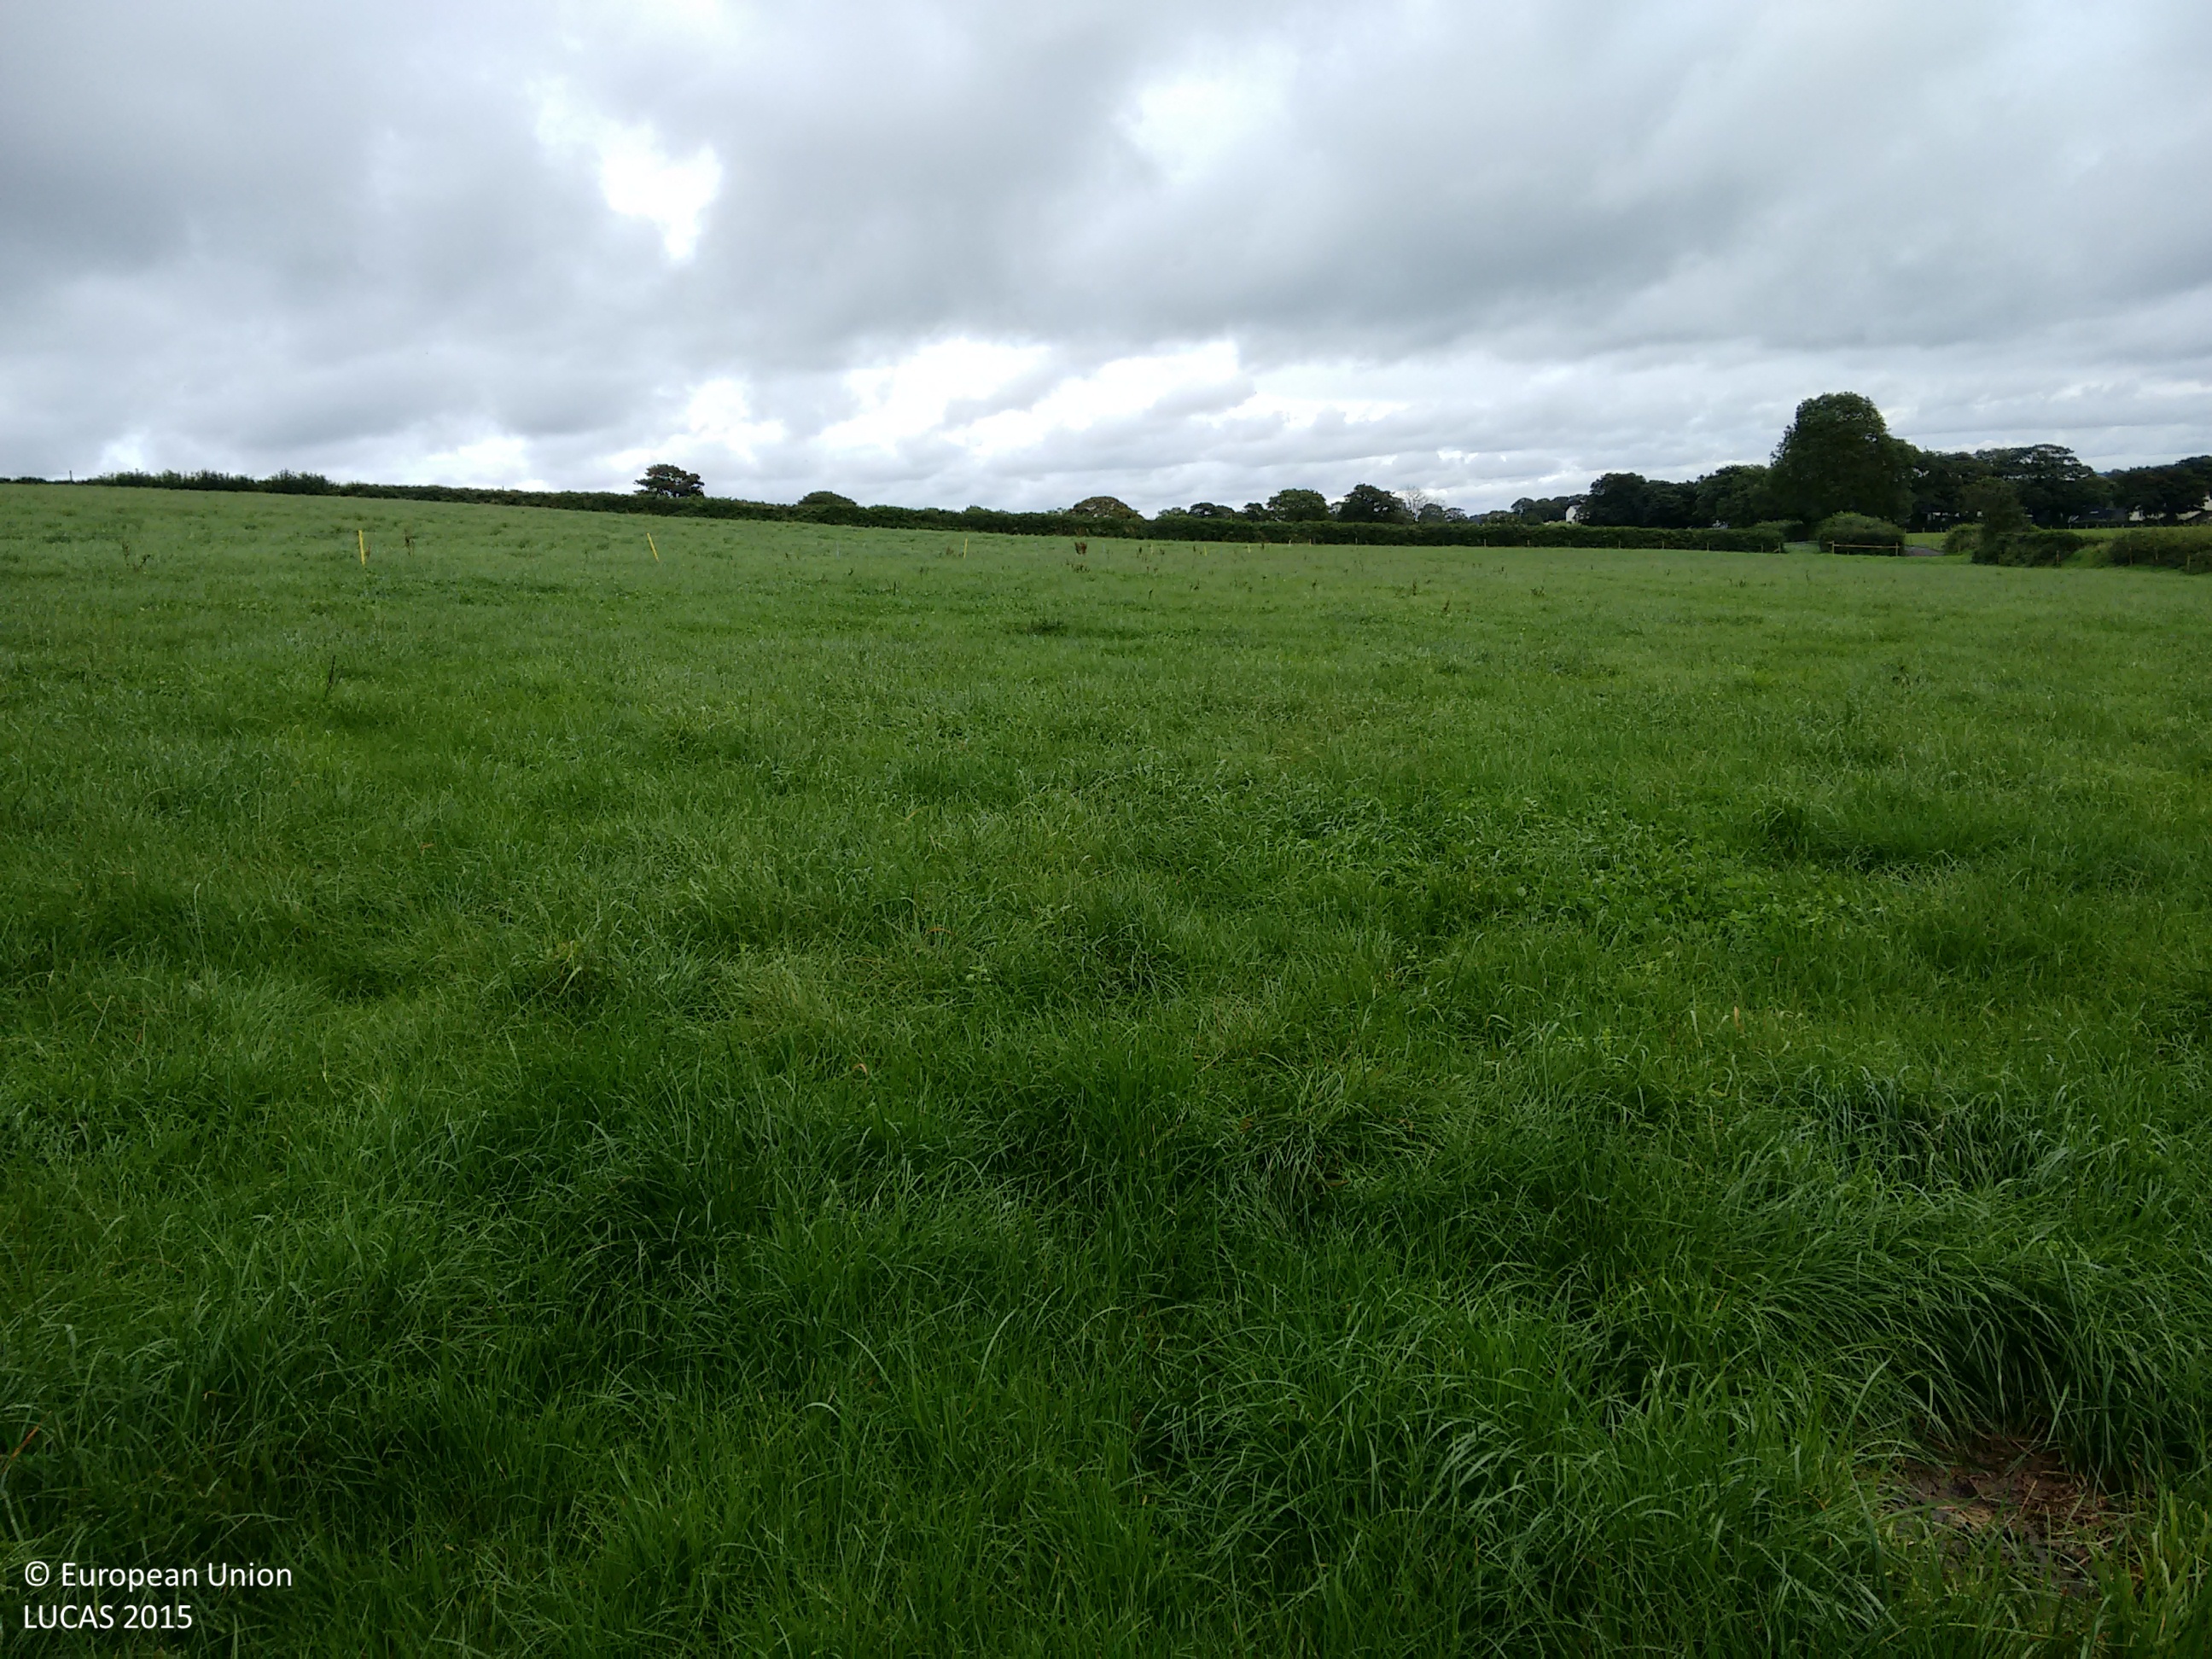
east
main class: Grassland
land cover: Grassland without tree/shrub cover
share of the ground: > 75 %
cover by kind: herbaceous plants 100 %
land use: Agriculture (excluding fallow land and kitchen gardens)
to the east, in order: Managed hedges; Fences; Grassland without tree/shrub cover; Fences; Managed hedges; Fences; Grassland without tree/shrub cover
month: August
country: GB
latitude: 51.8569
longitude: -4.8508
